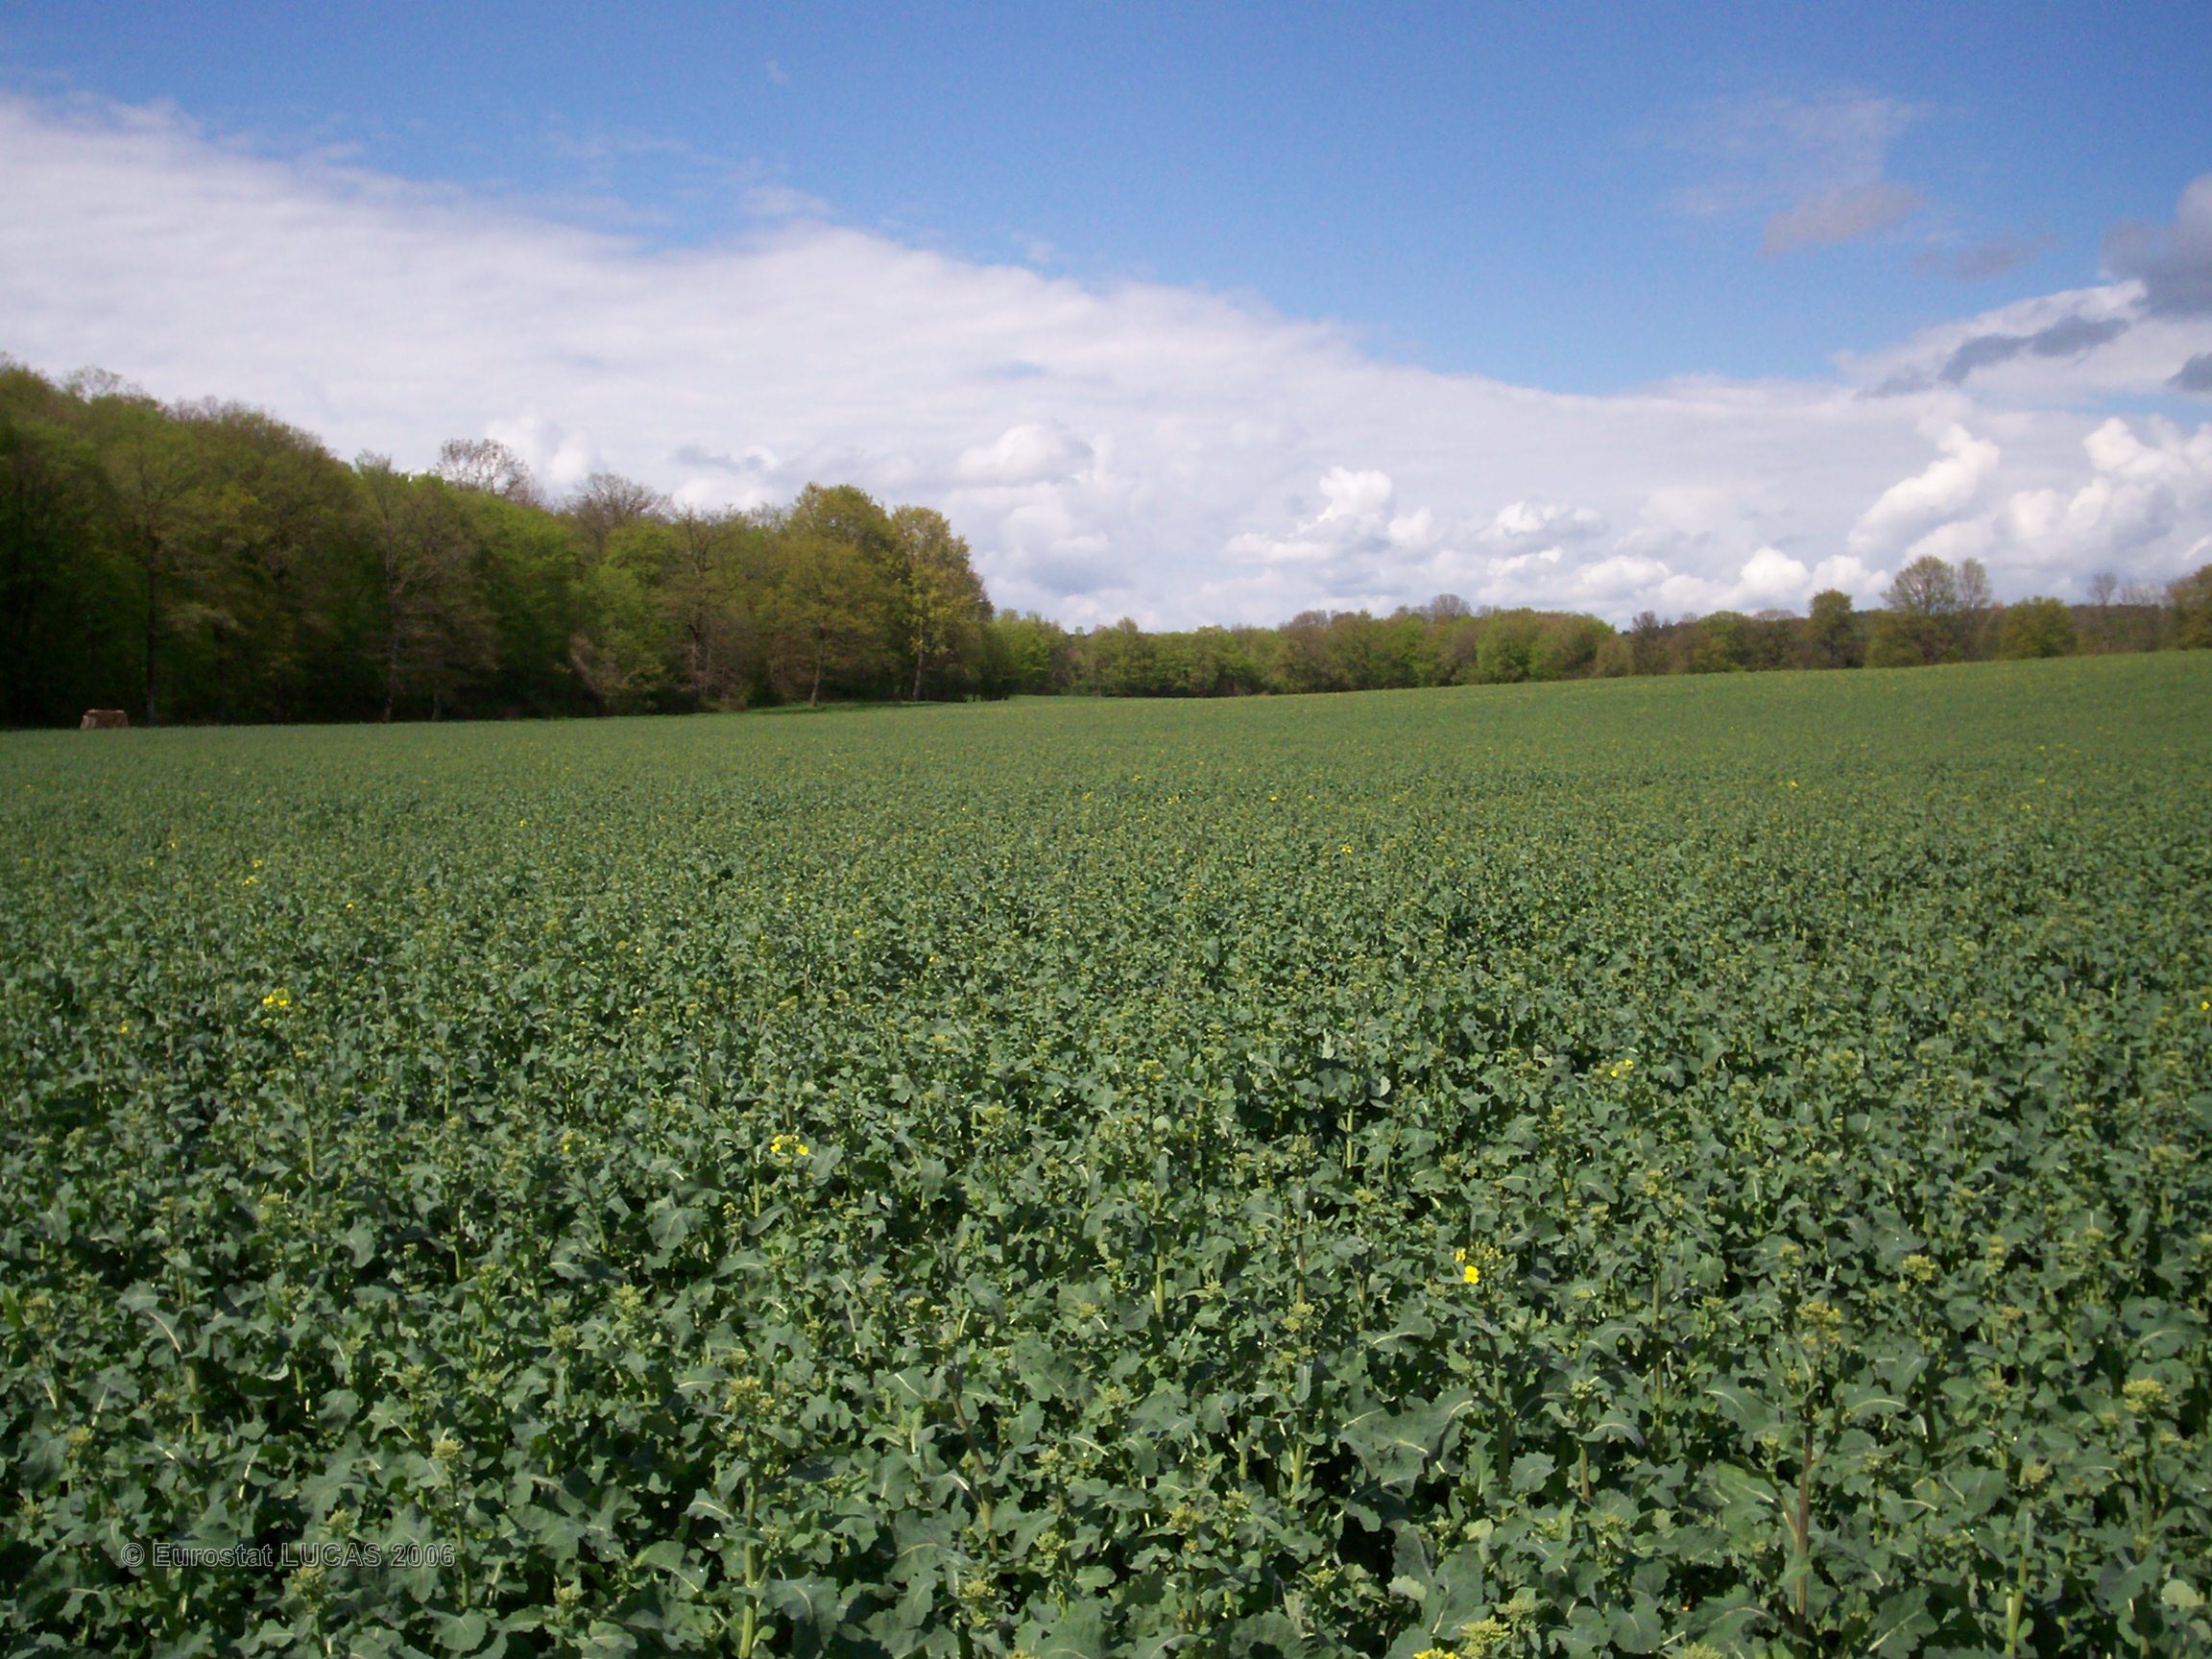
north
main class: Cropland
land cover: Rape and turnip rape
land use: Agriculture (excluding fallow land and kitchen gardens)
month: April
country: FR
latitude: 47.5413
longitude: 6.0821
